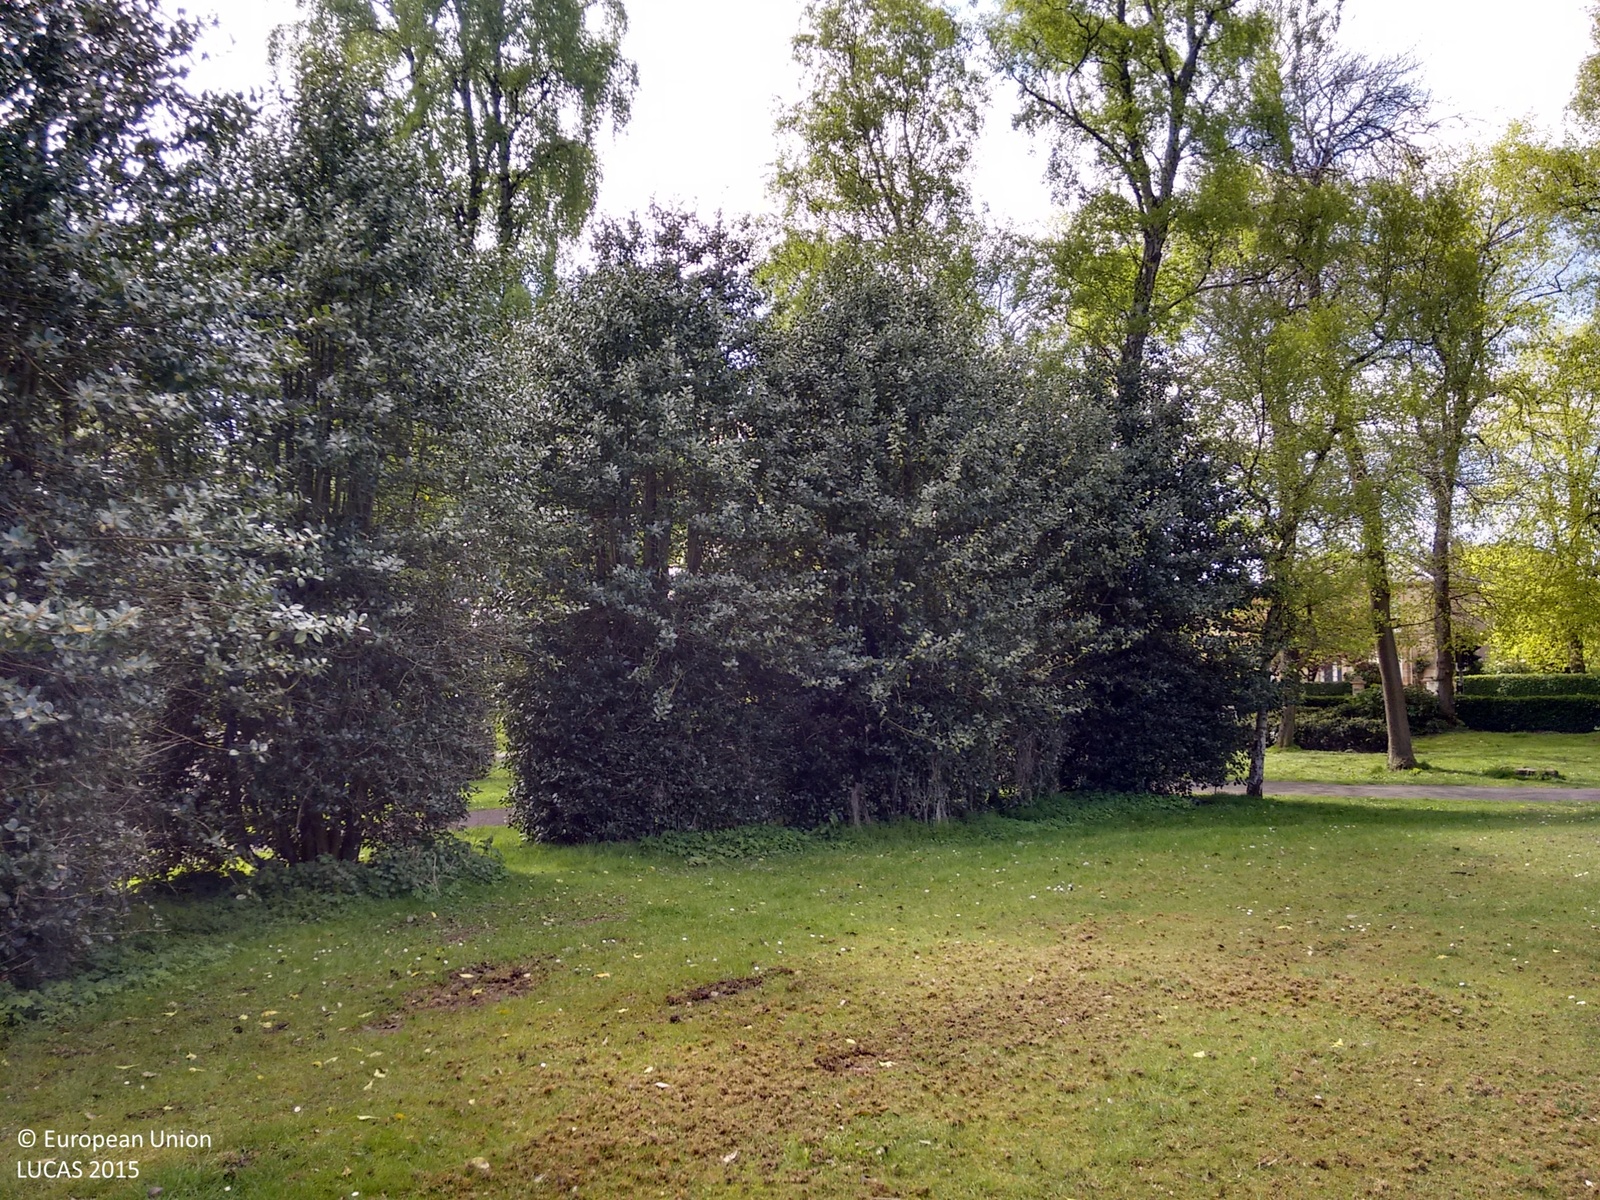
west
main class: Grassland
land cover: Grassland without tree/shrub cover
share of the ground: > 75 %
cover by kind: herbaceous plants 100 %
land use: Amenities, museums, leisure
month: May
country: GB
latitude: 55.8395
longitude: -4.2901
